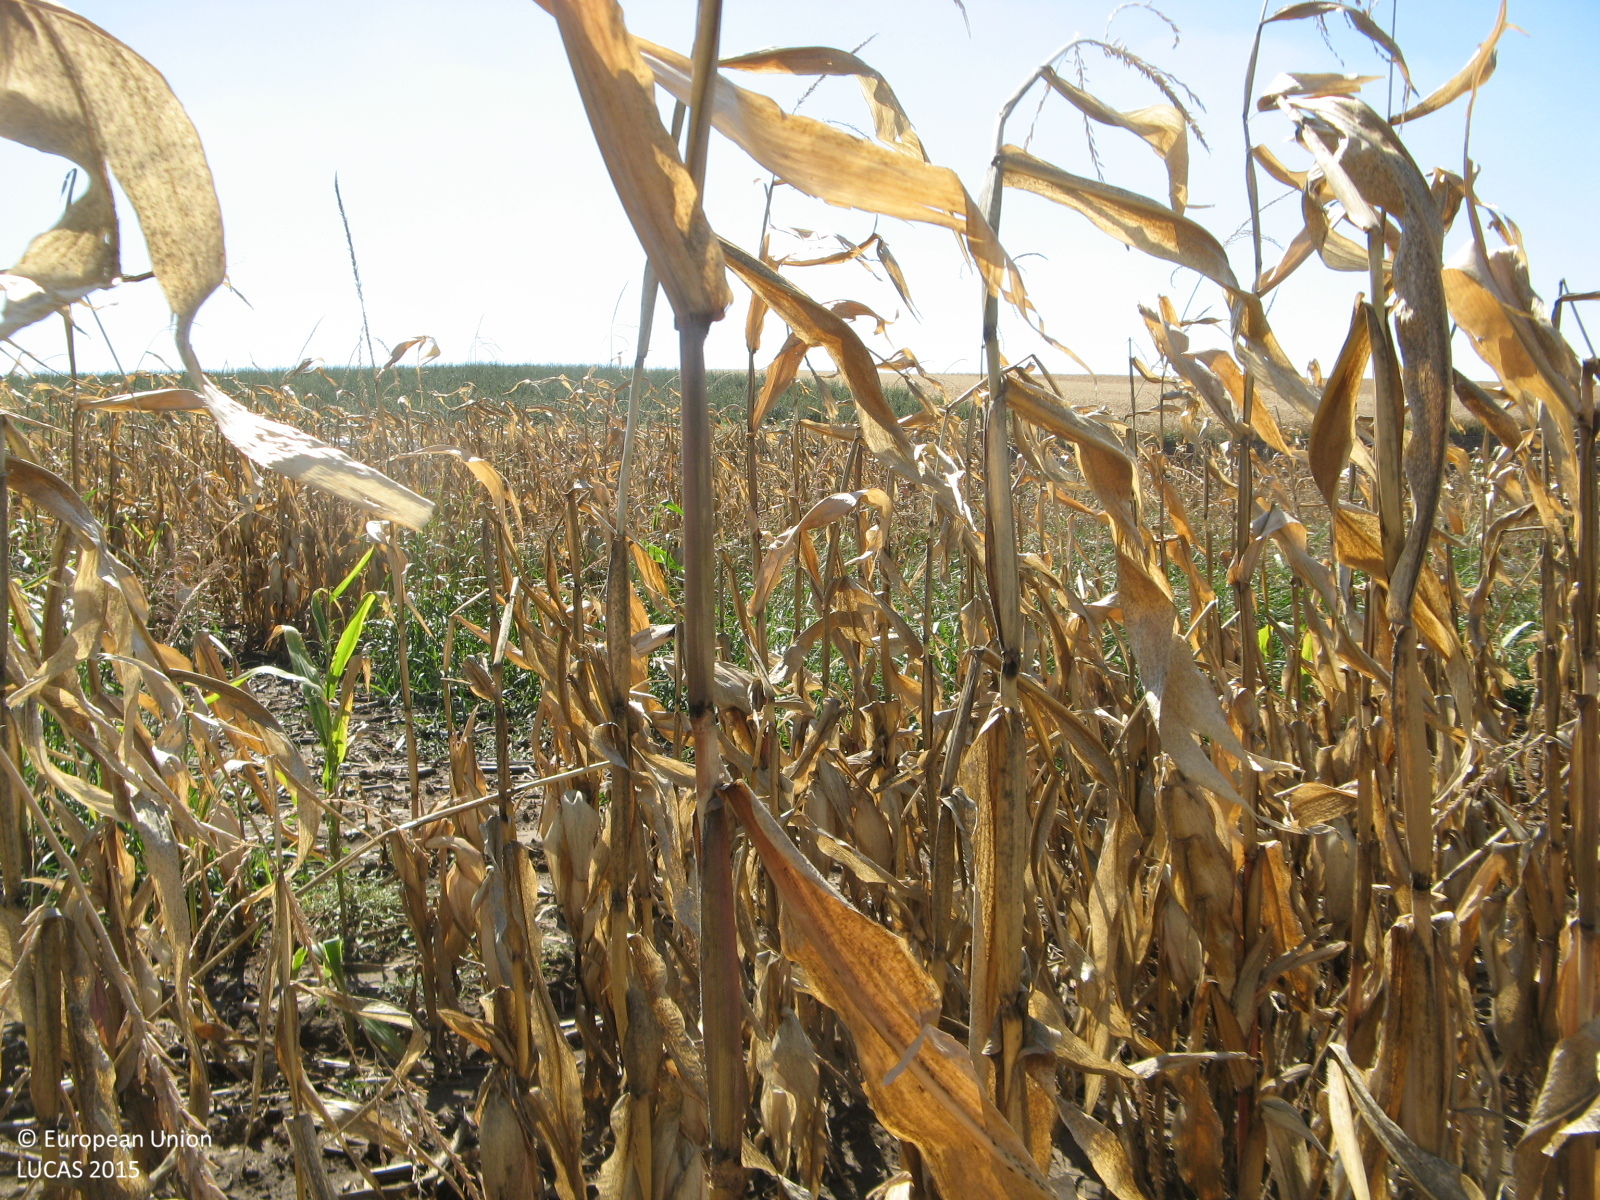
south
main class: Cropland
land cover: Maize
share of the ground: > 75 %
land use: Agriculture (excluding fallow land and kitchen gardens)
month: September
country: BG
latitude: 43.5252
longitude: 25.3843
